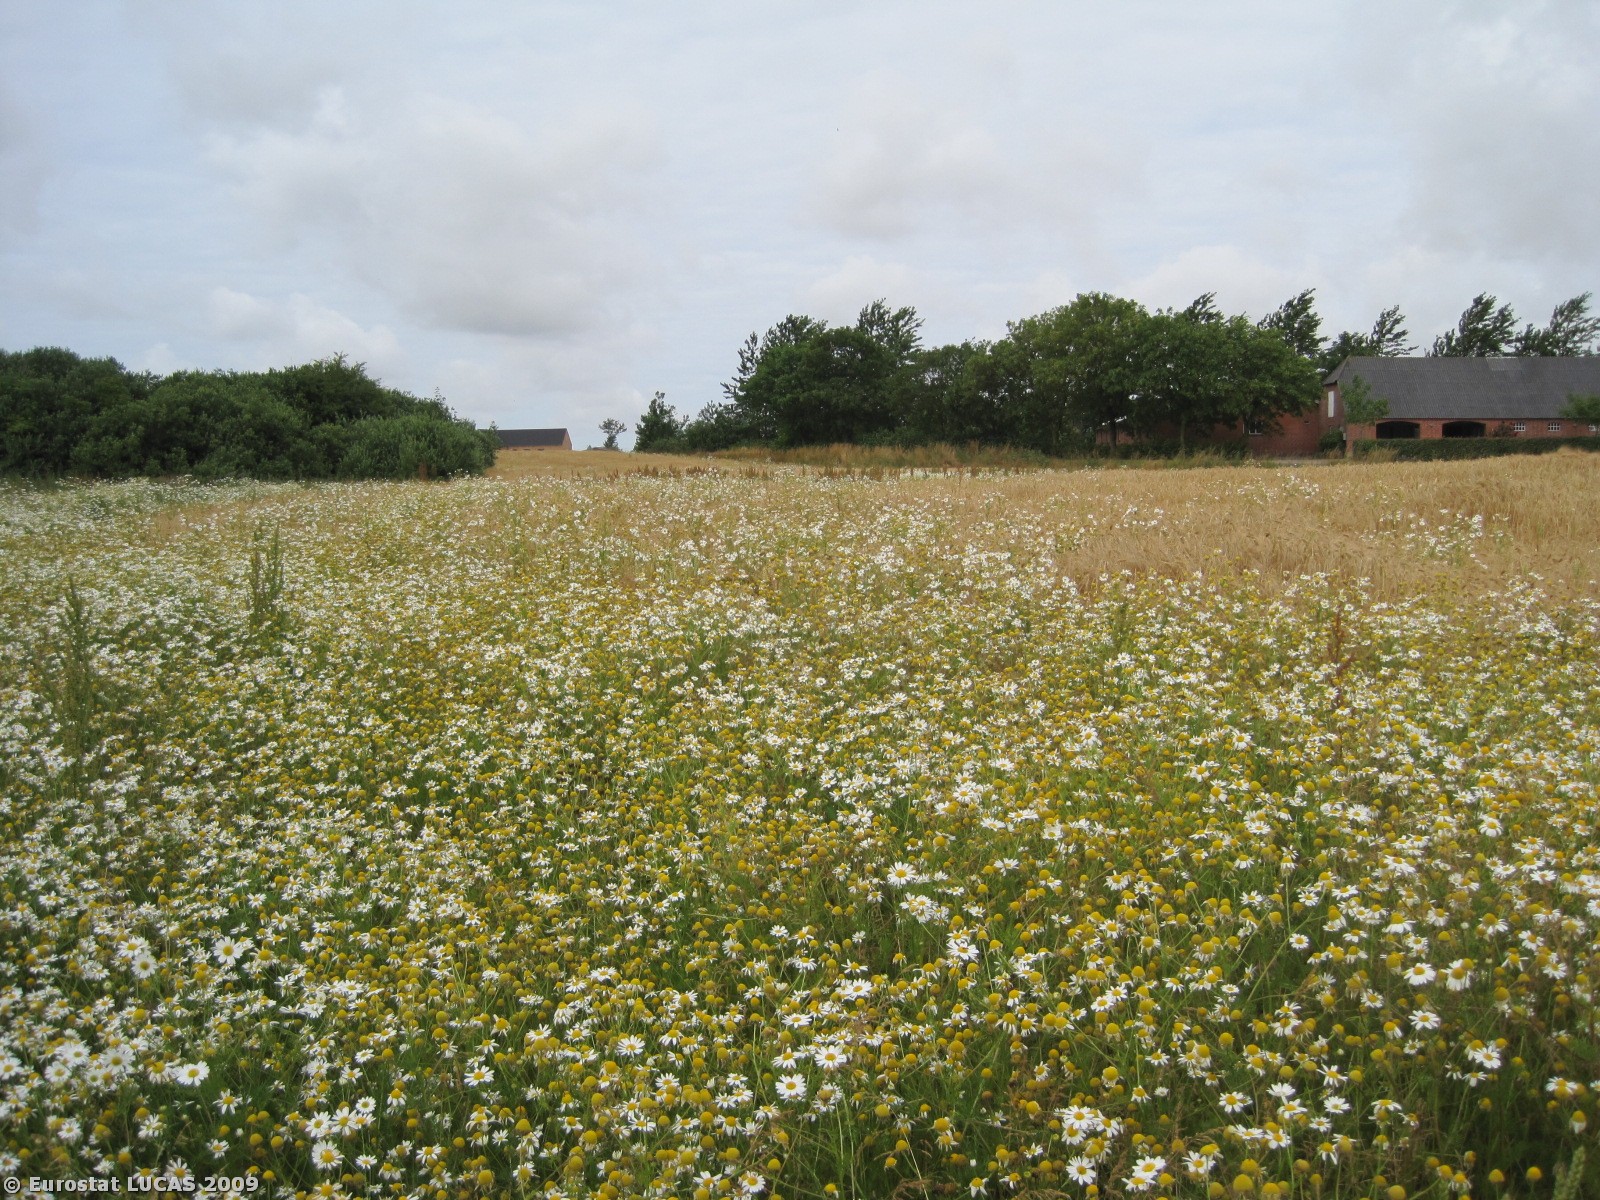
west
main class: Grassland
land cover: Grassland without tree/shrub cover
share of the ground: > 75 %
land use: Unused
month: July
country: DK
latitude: 56.3971
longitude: 8.7216
